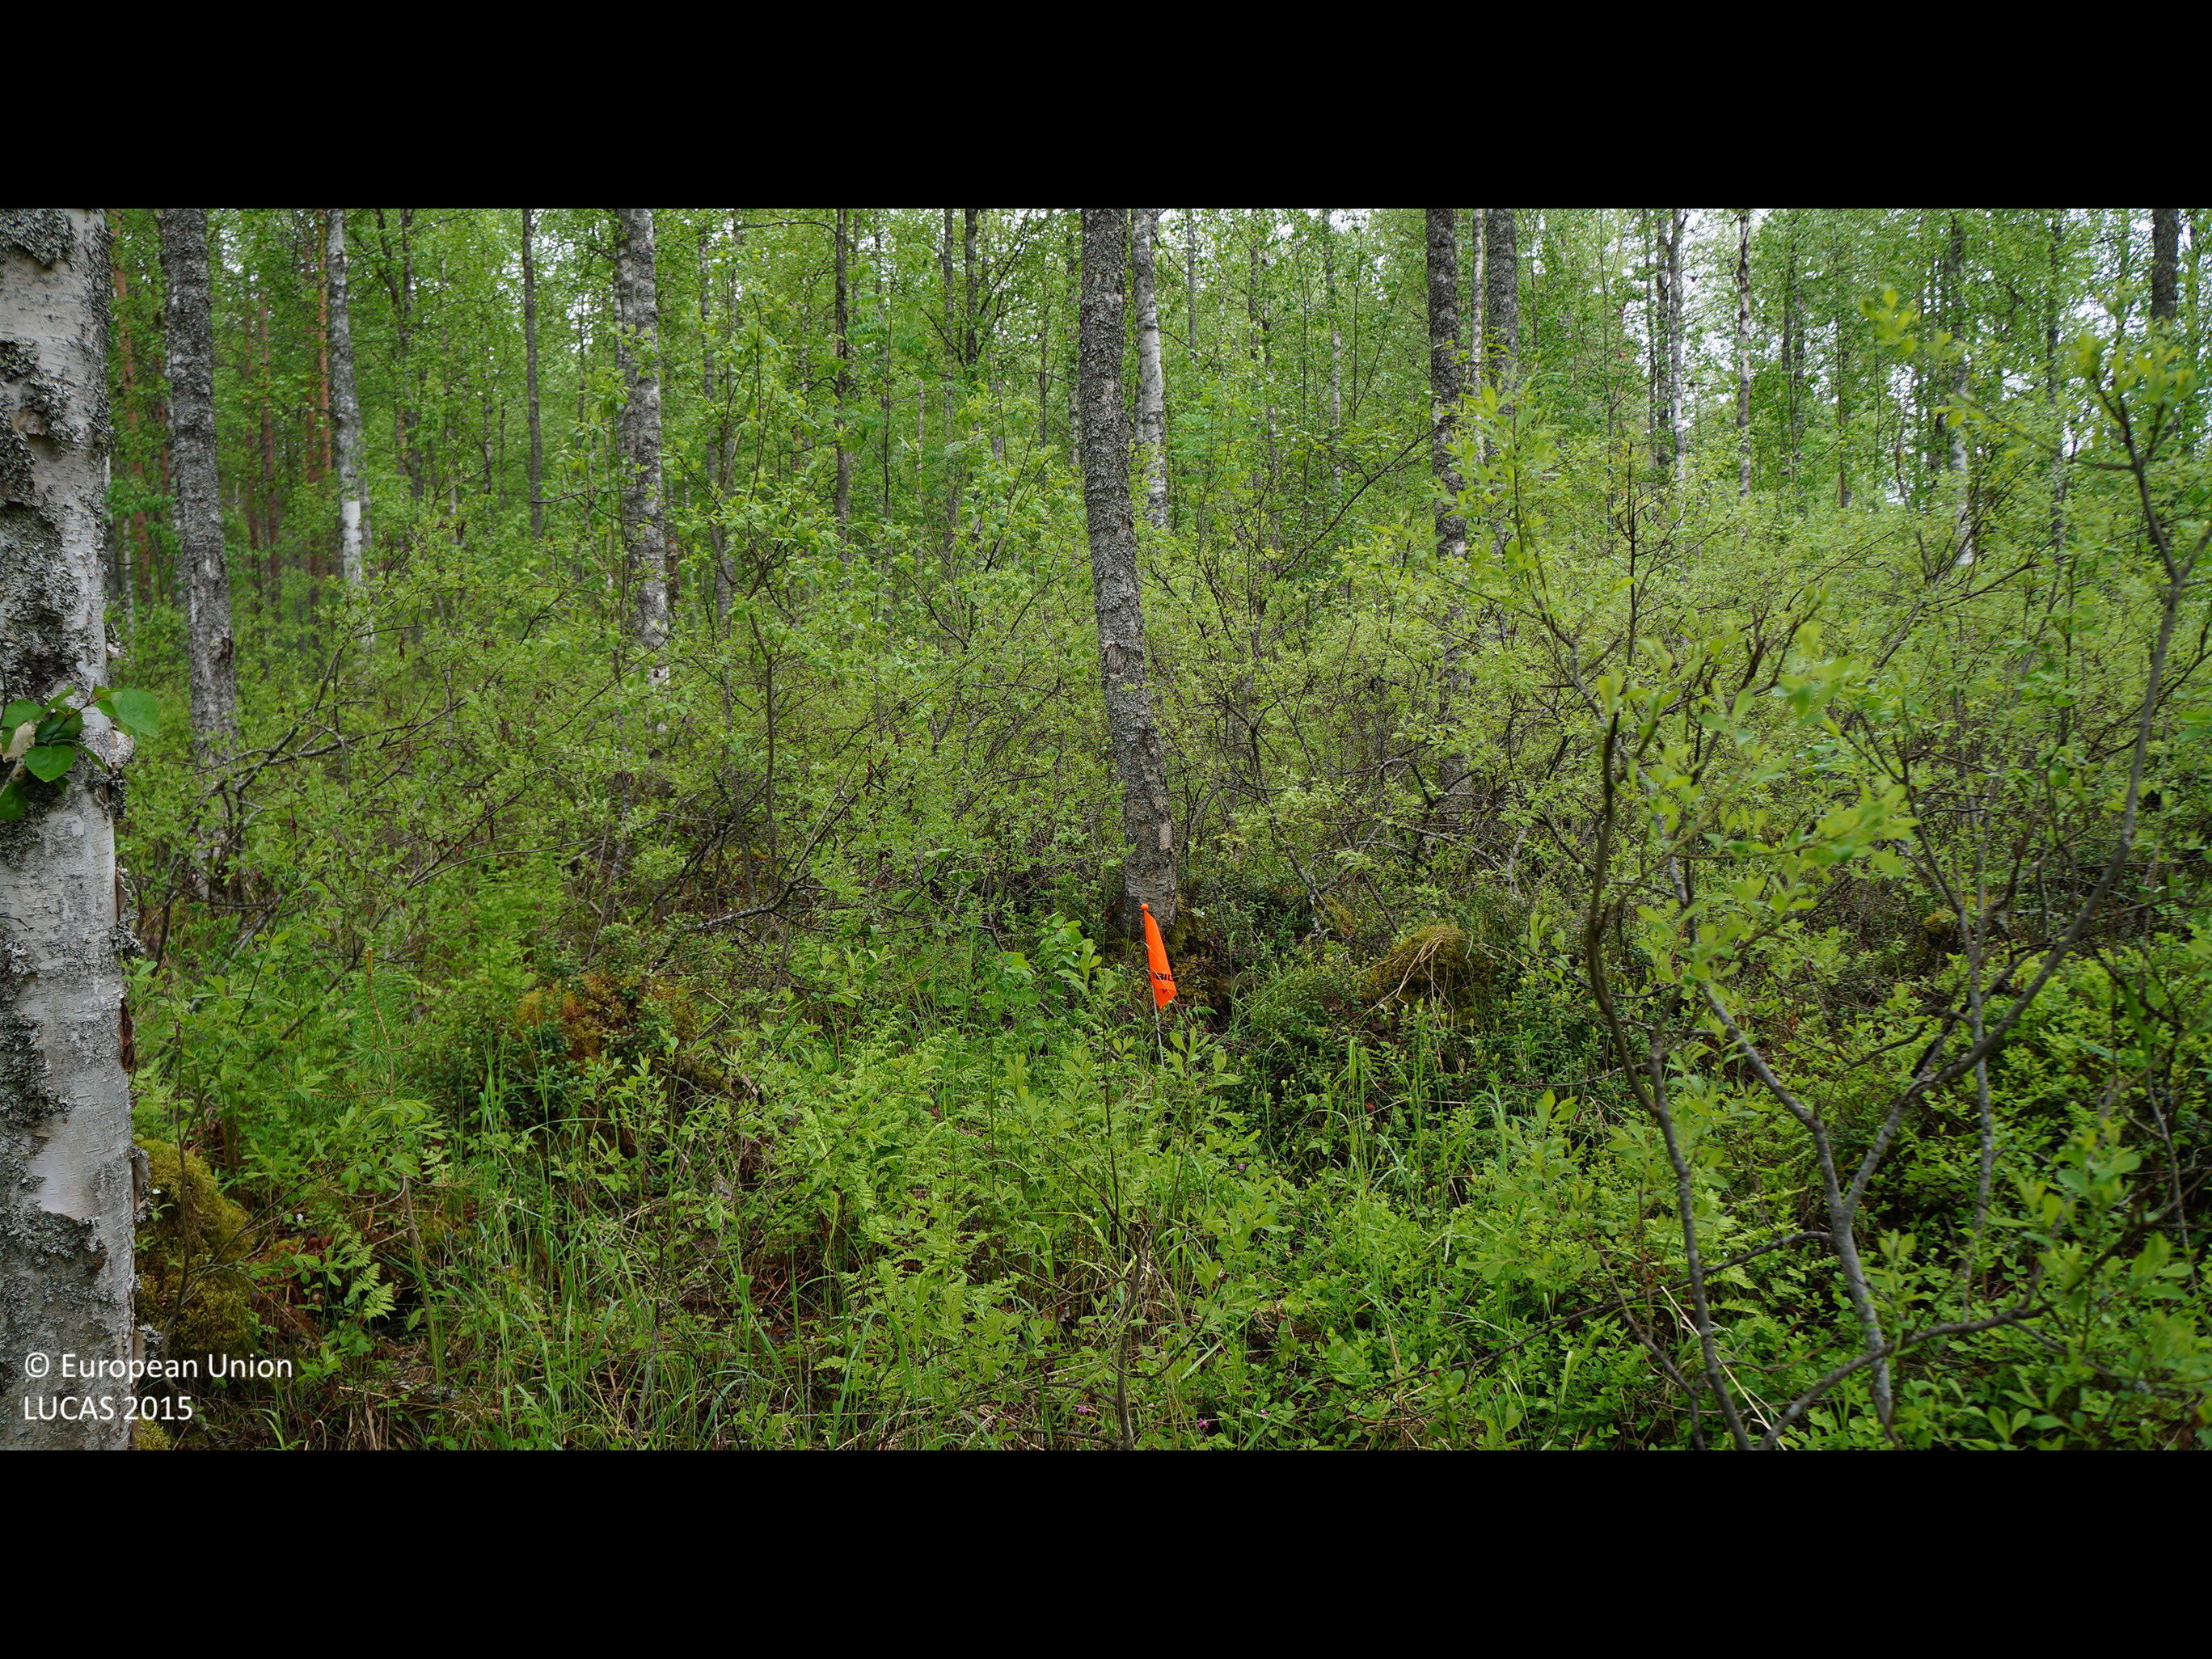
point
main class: Woodland
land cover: Broadleaved woodland
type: boreal forest
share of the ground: 50 - 75 %
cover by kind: broadleaved forest trees 65 %, shrubs 25 %, coniferous forest trees 5 %, herbaceous plants 5 %
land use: Forestry
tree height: > 5 m
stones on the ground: < 10 %
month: June
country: FI
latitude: 64.2772
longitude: 25.3077
